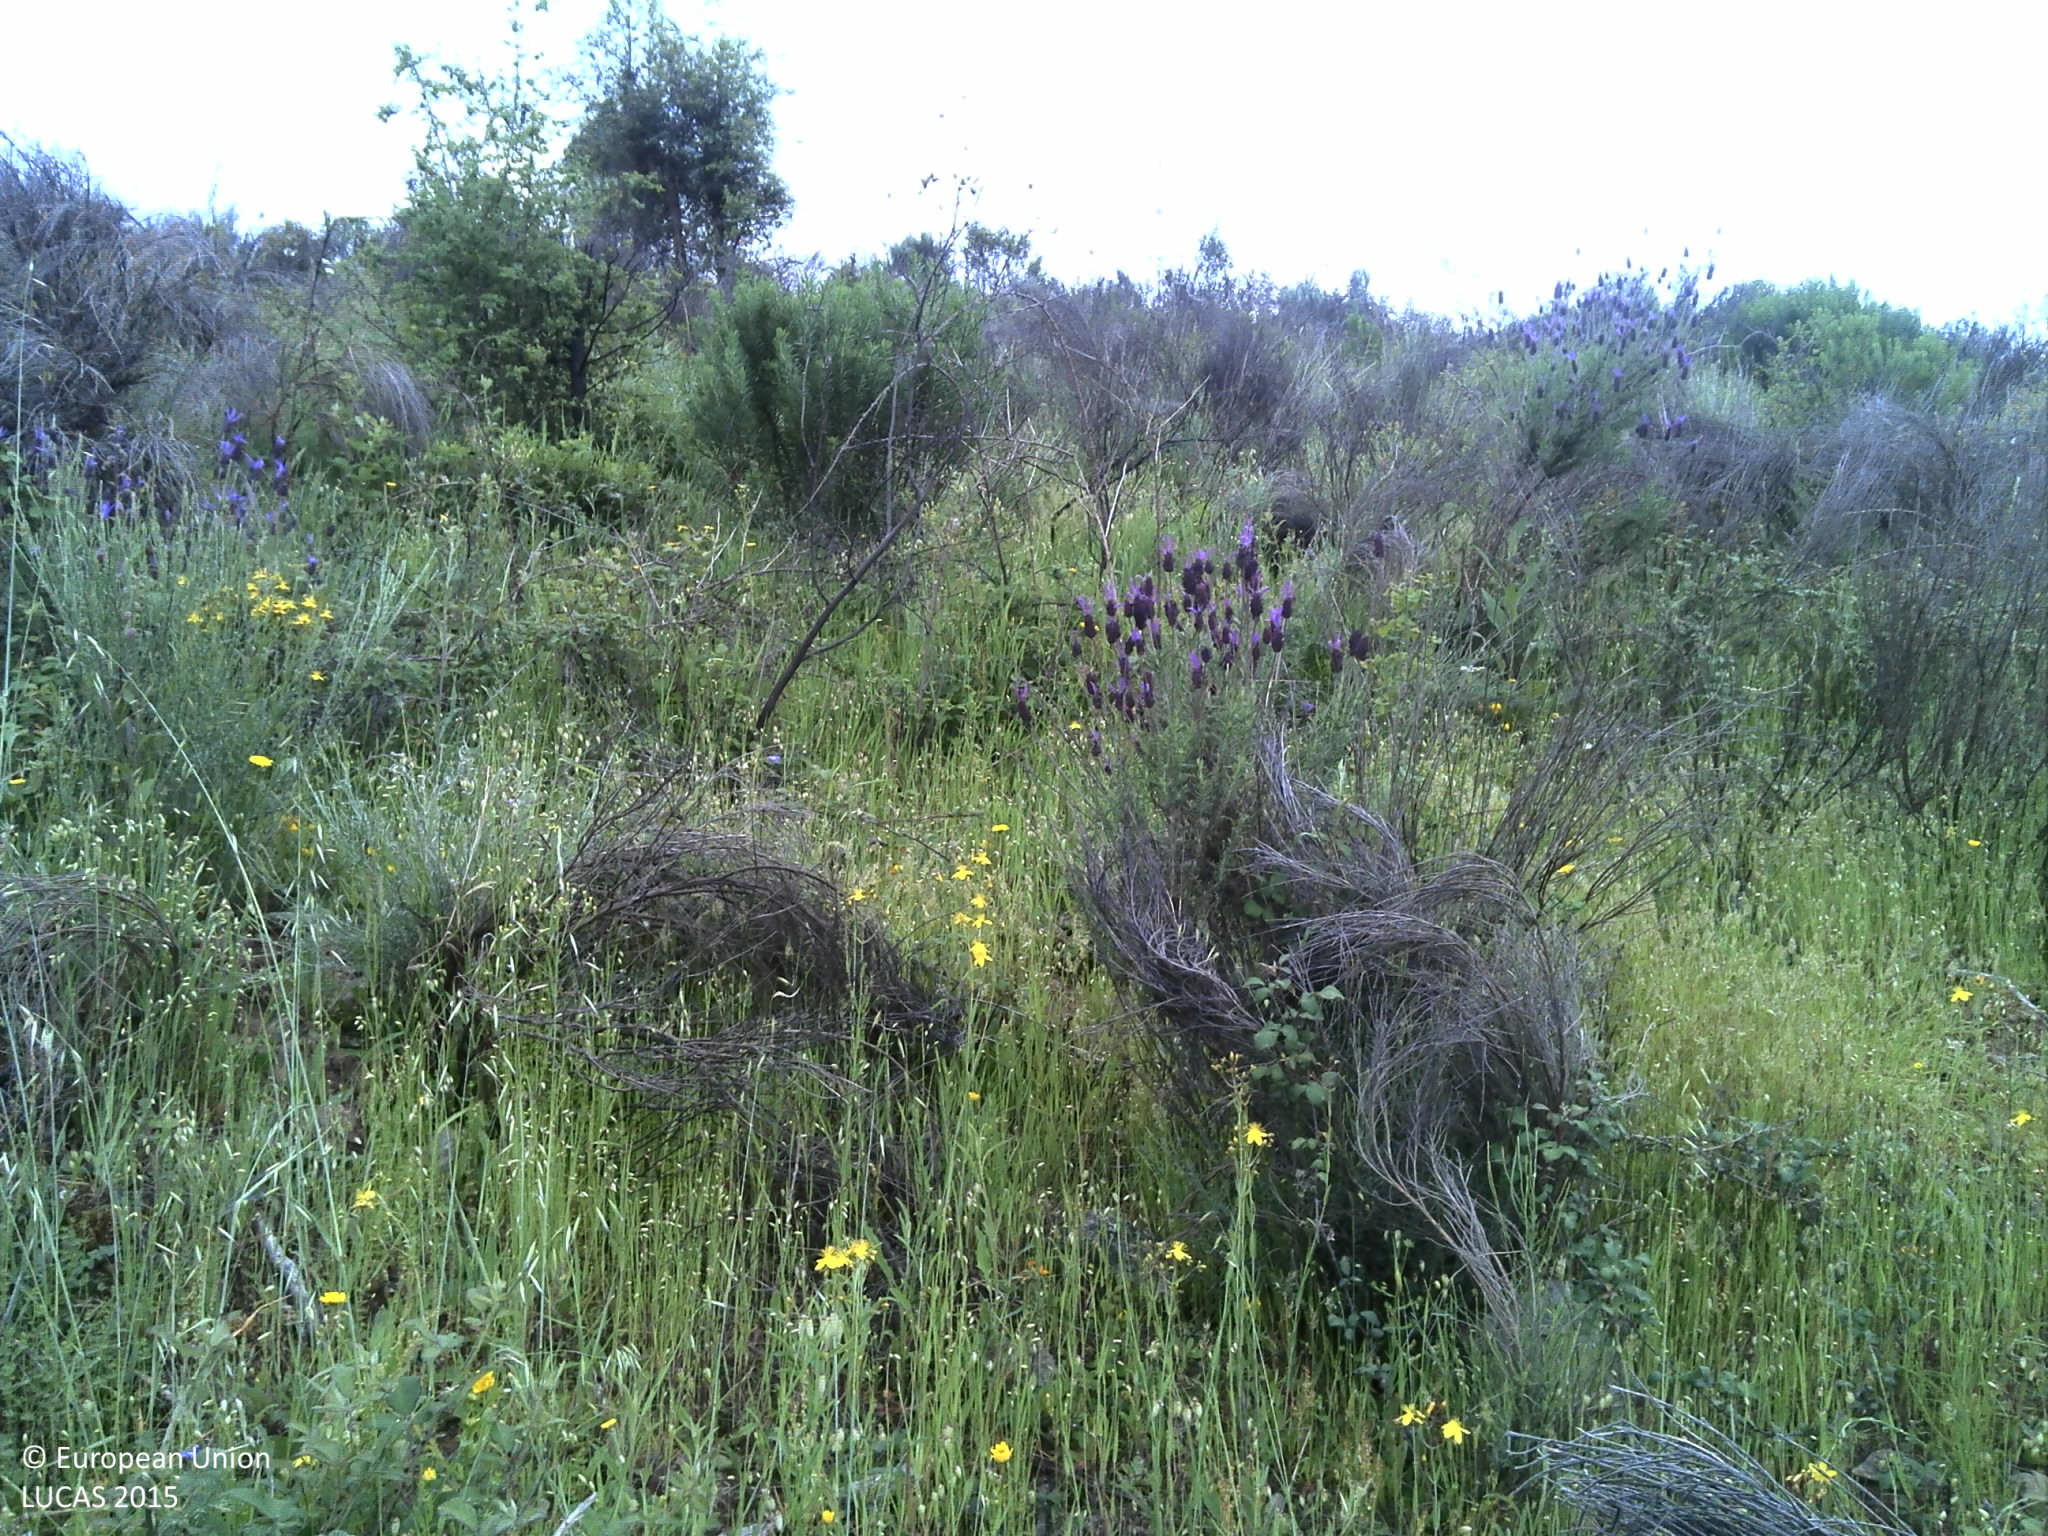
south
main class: Shrubland
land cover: Shrubland with sparse tree cover
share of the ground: 50 - 75 %
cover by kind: shrubs 75 %, herbaceous plants 15 %, broadleaved forest trees 5 %, unconsolidated bare surface 5 %
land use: Semi-natural and natural areas not in use
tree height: > 5 m
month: May
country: PT
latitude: 41.6232
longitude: -7.0283
